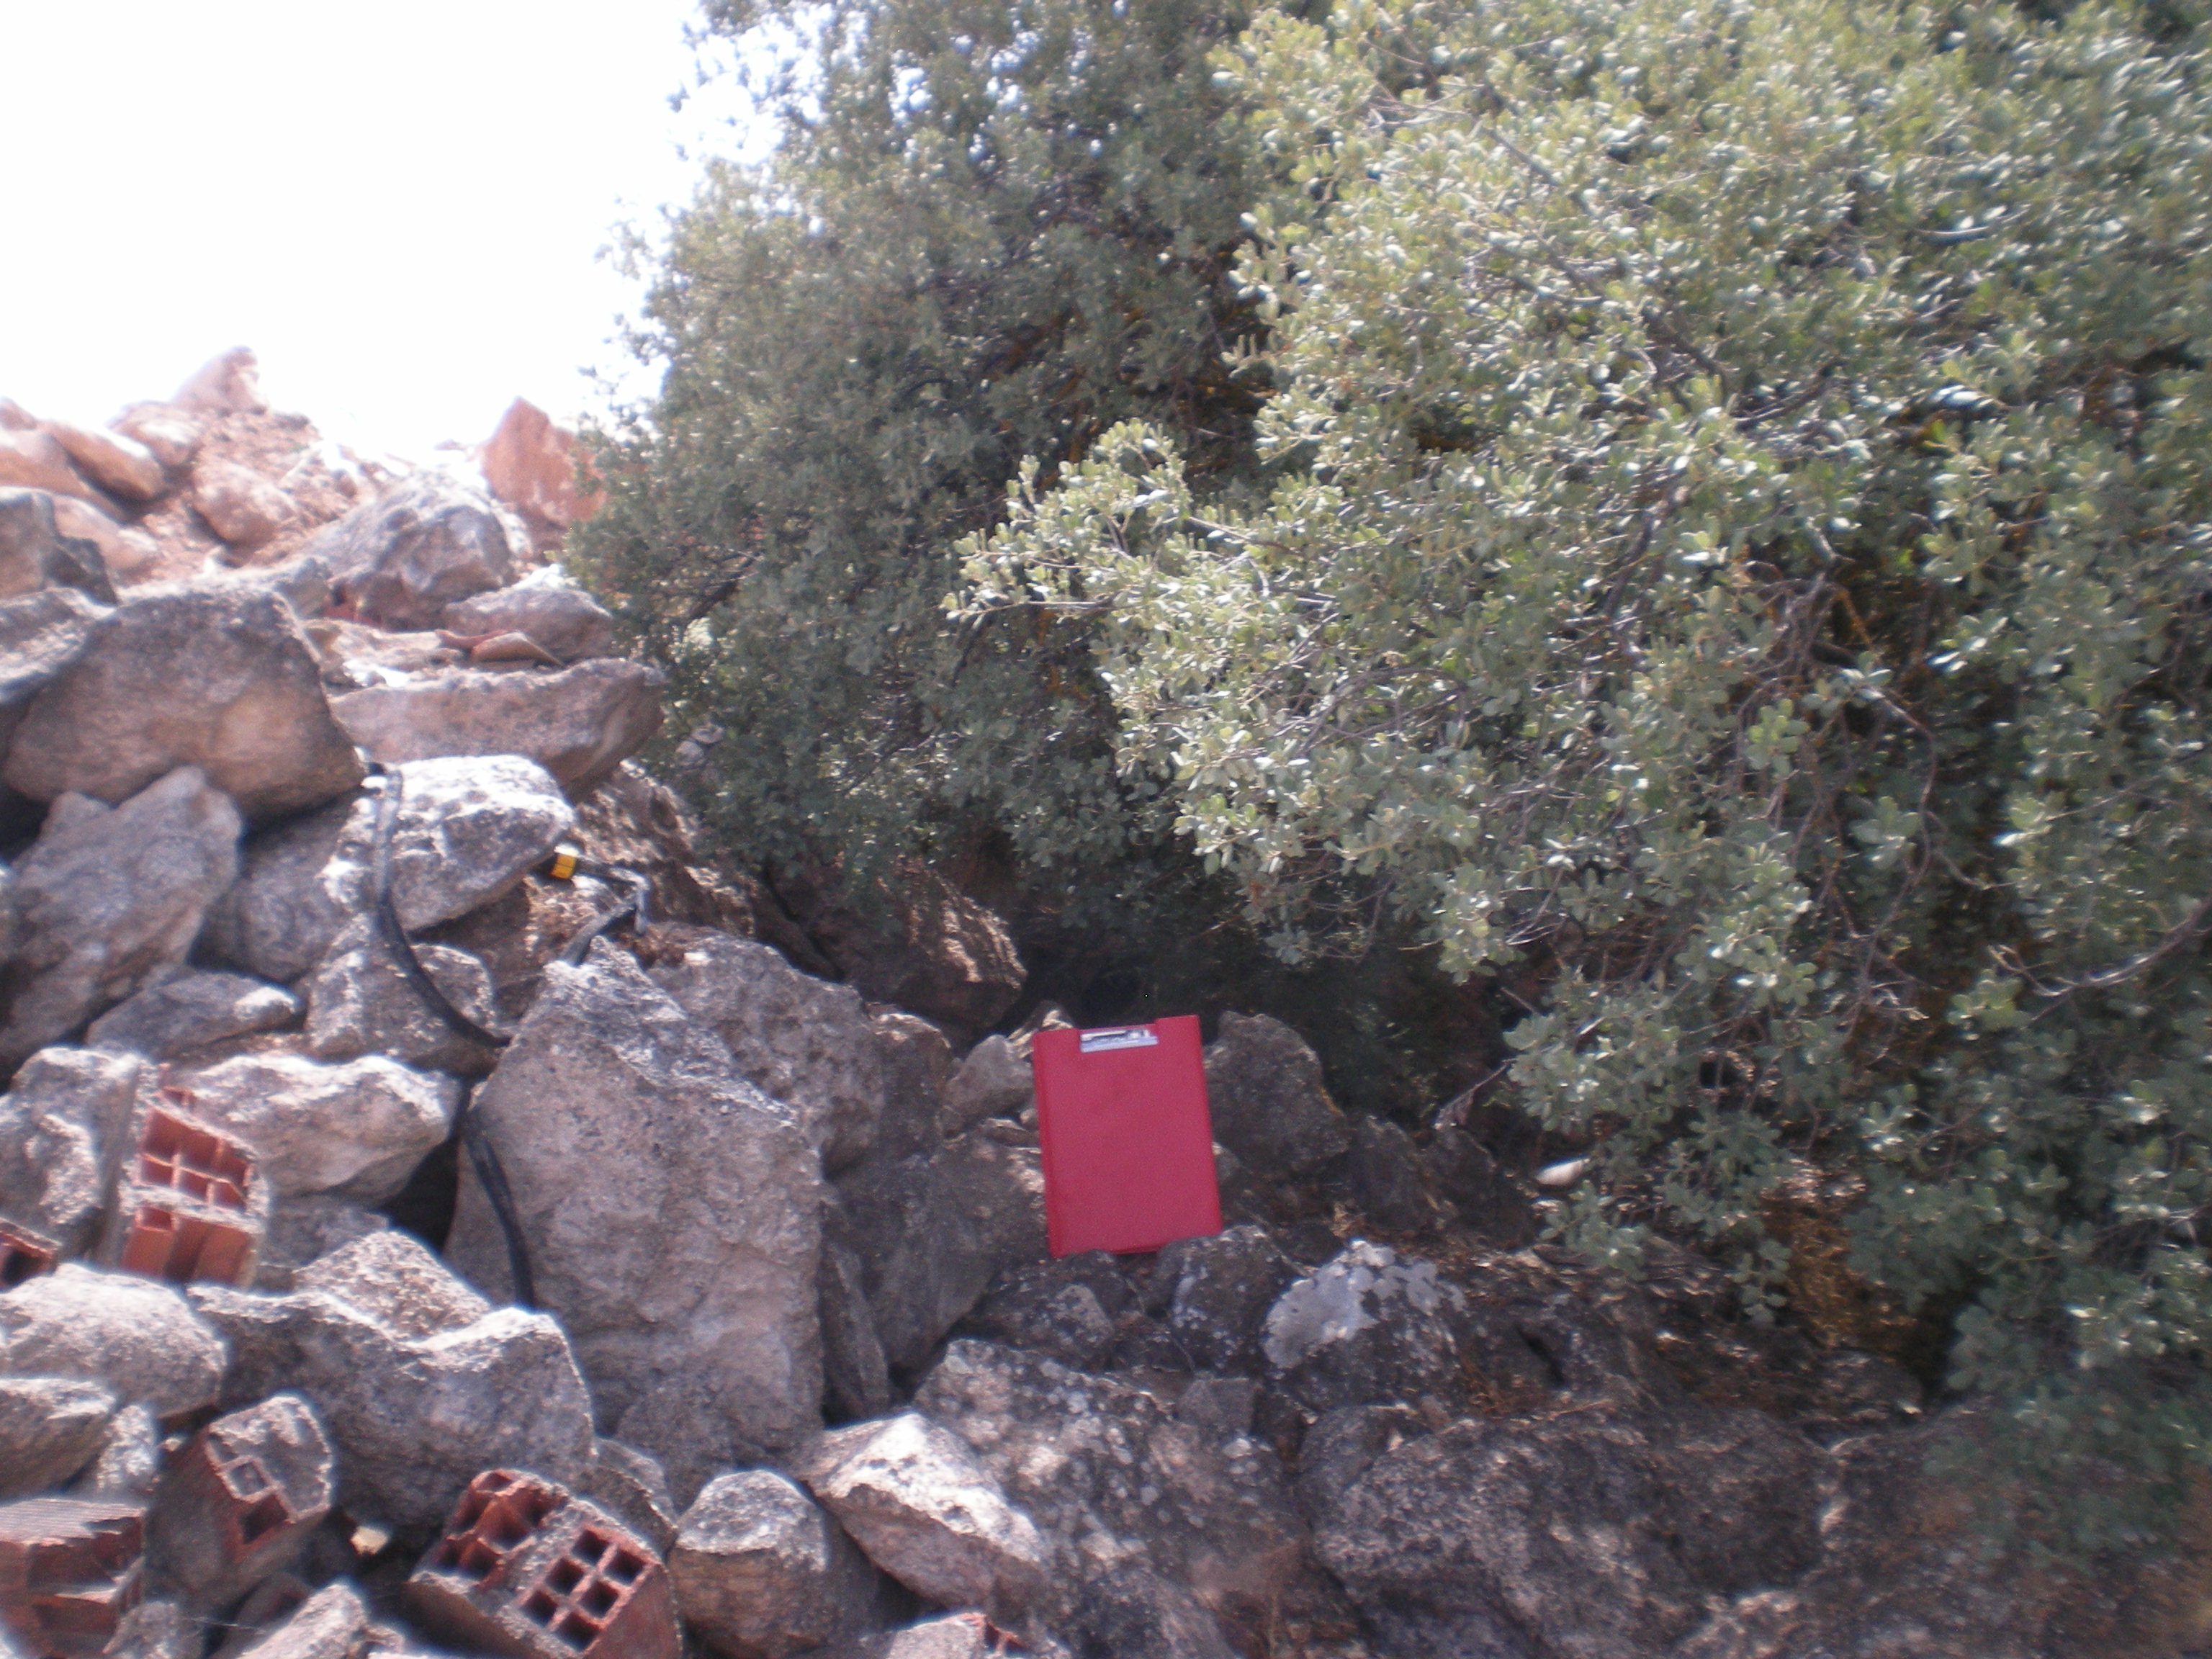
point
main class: Woodland
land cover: Broadleaved woodland
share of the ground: 25 - 50 %
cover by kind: unconsolidated bare surface 65 %, broadleaved forest trees 35 %
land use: Semi-natural and natural areas not in use
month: July
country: ES
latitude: 39.2559
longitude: -3.2389
